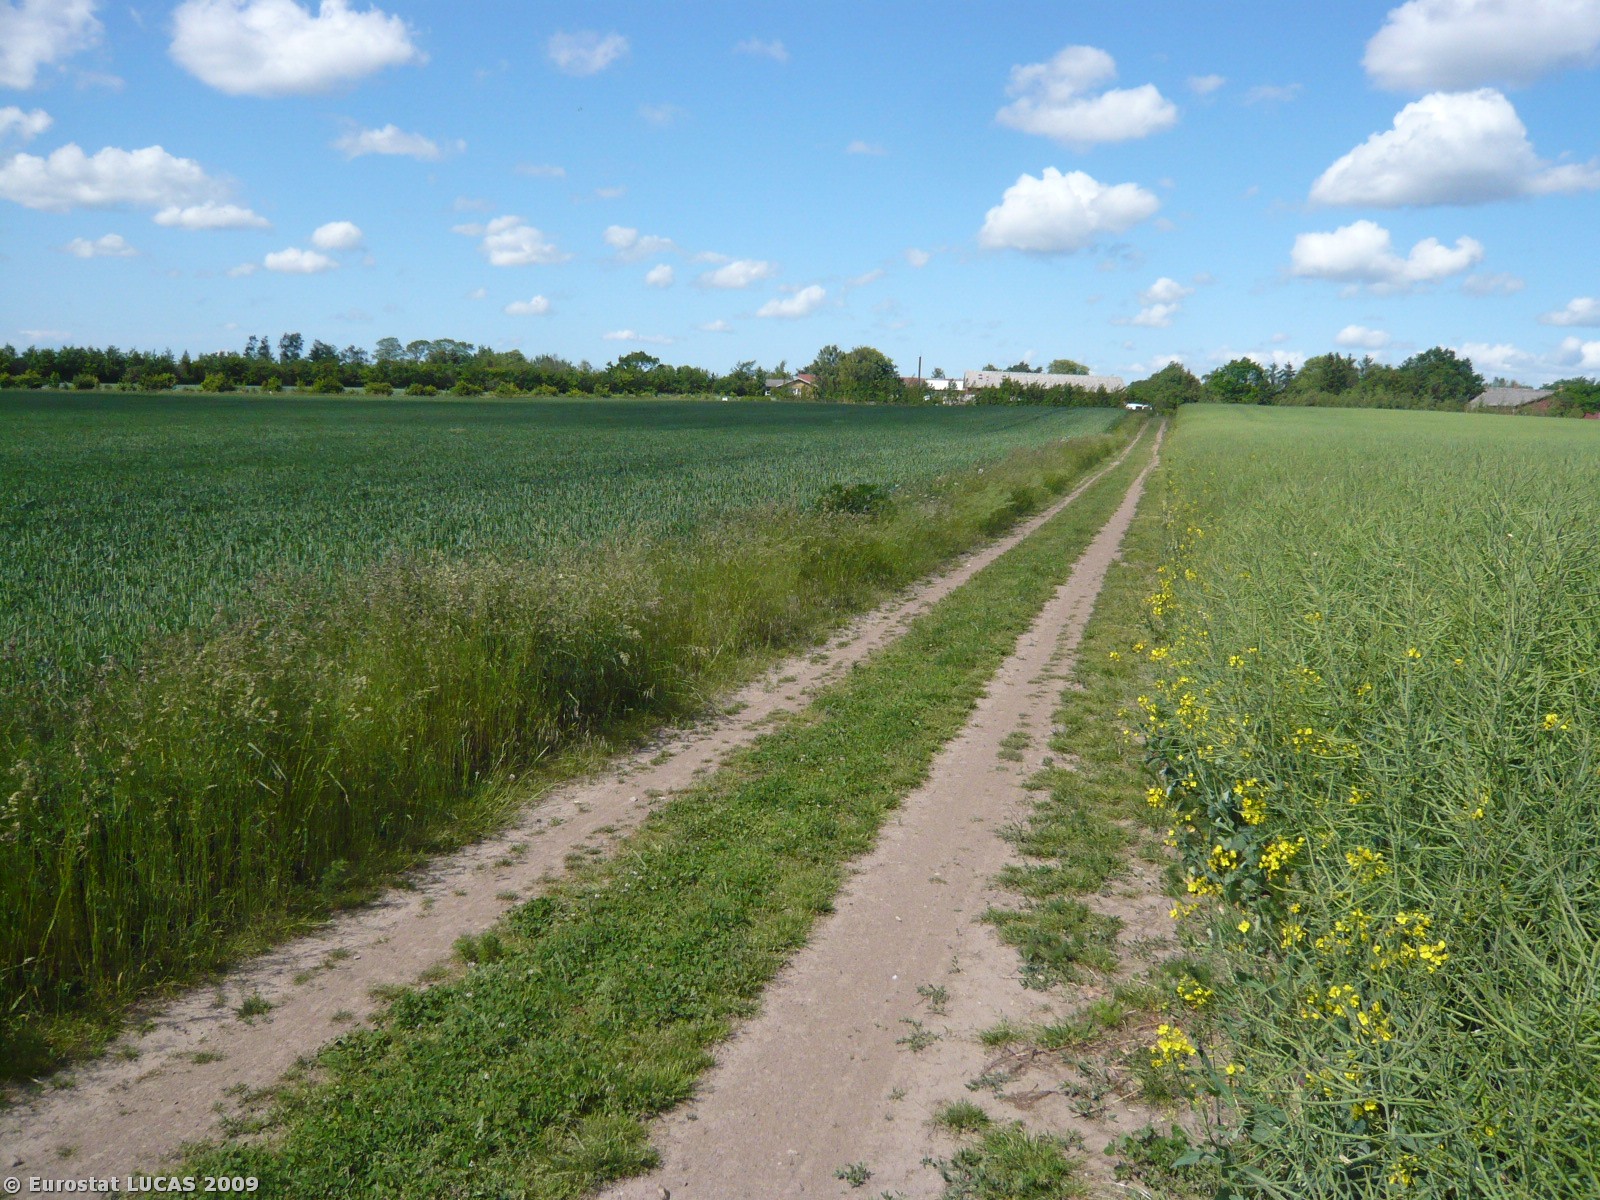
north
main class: Cropland
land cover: Rape and turnip rape
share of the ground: > 75 %
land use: Agriculture (excluding fallow land and kitchen gardens)
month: June
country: DK
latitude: 55.3179
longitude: 11.3383
